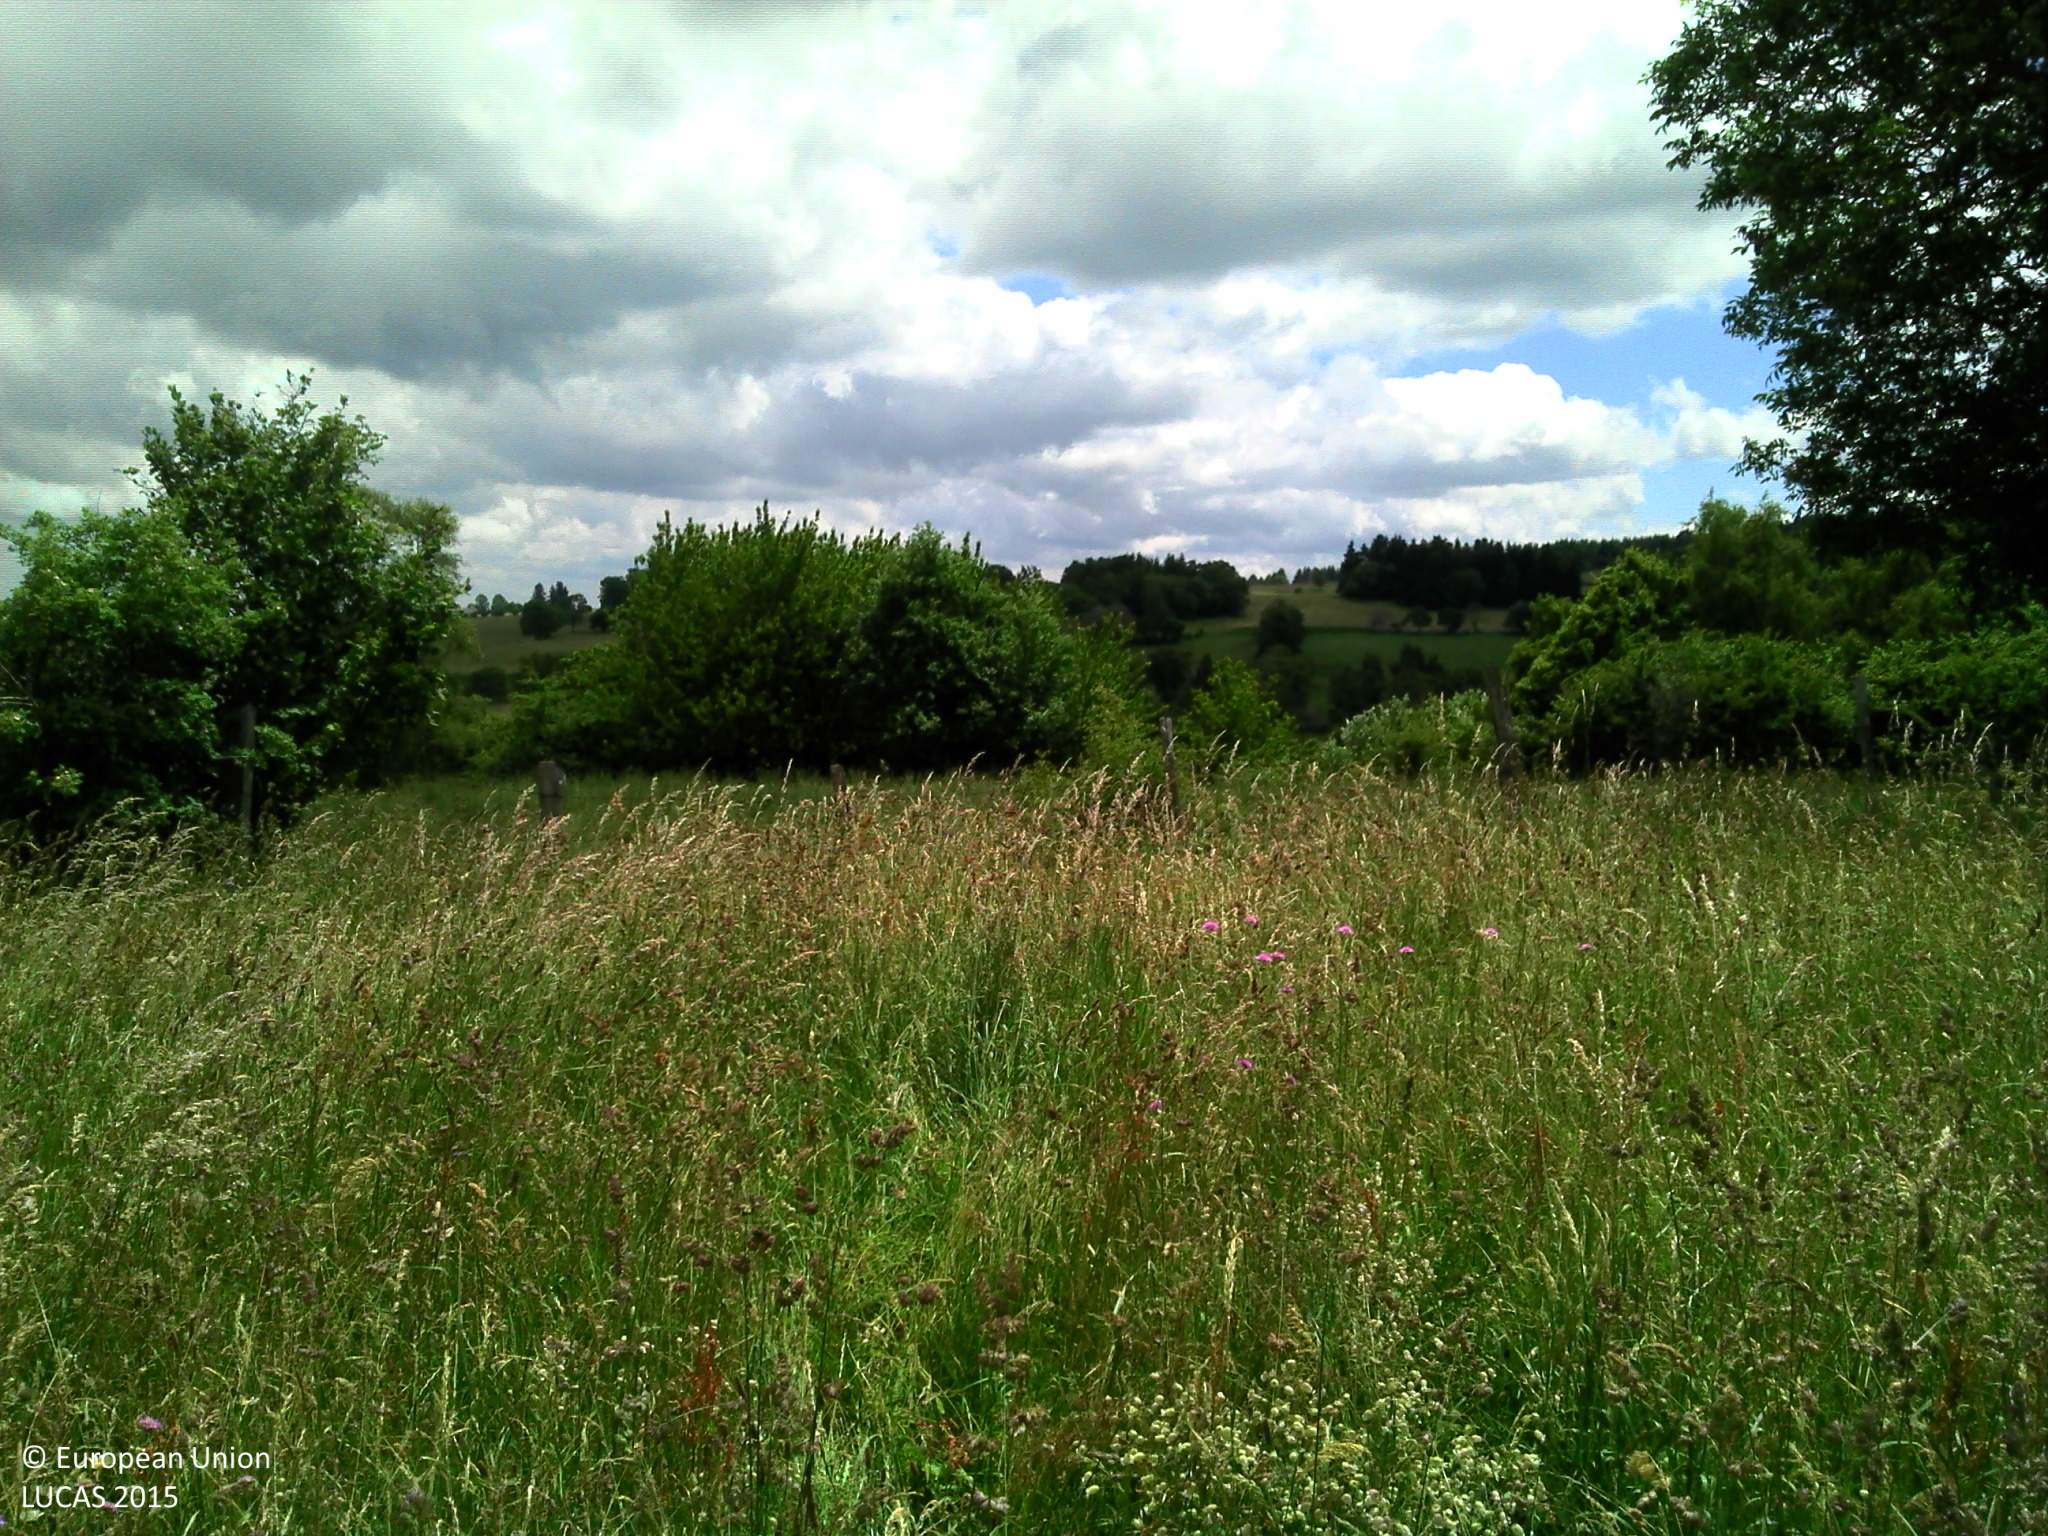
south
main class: Grassland
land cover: Grassland without tree/shrub cover
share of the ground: > 75 %
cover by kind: herbaceous plants 100 %
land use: Agriculture (excluding fallow land and kitchen gardens)
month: June
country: FR
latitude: 45.0647
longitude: 2.8767
